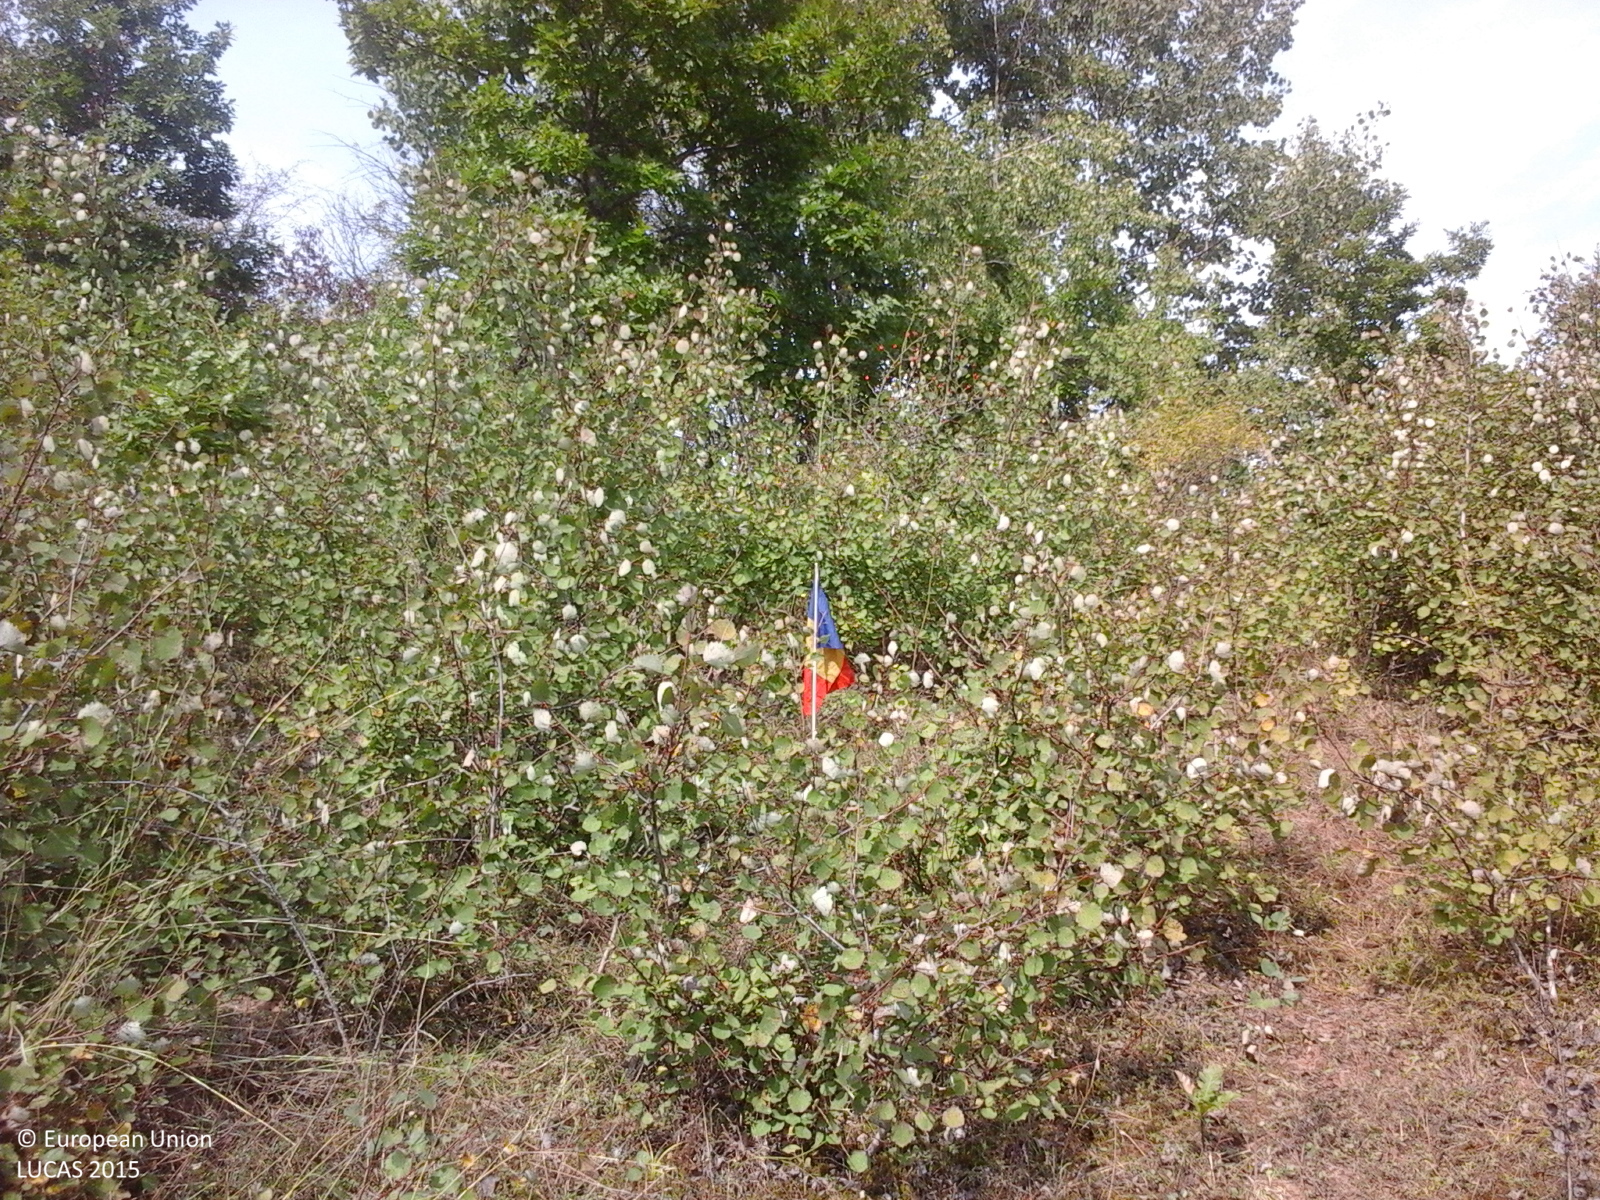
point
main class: Shrubland
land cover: Shrubland with sparse tree cover
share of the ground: > 75 %
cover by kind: herbaceous plants 55 %, shrubs 40 %, broadleaved forest trees 5 %
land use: Fallow land
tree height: < 5 m
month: September
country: RO
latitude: 47.0119
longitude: 23.1532
